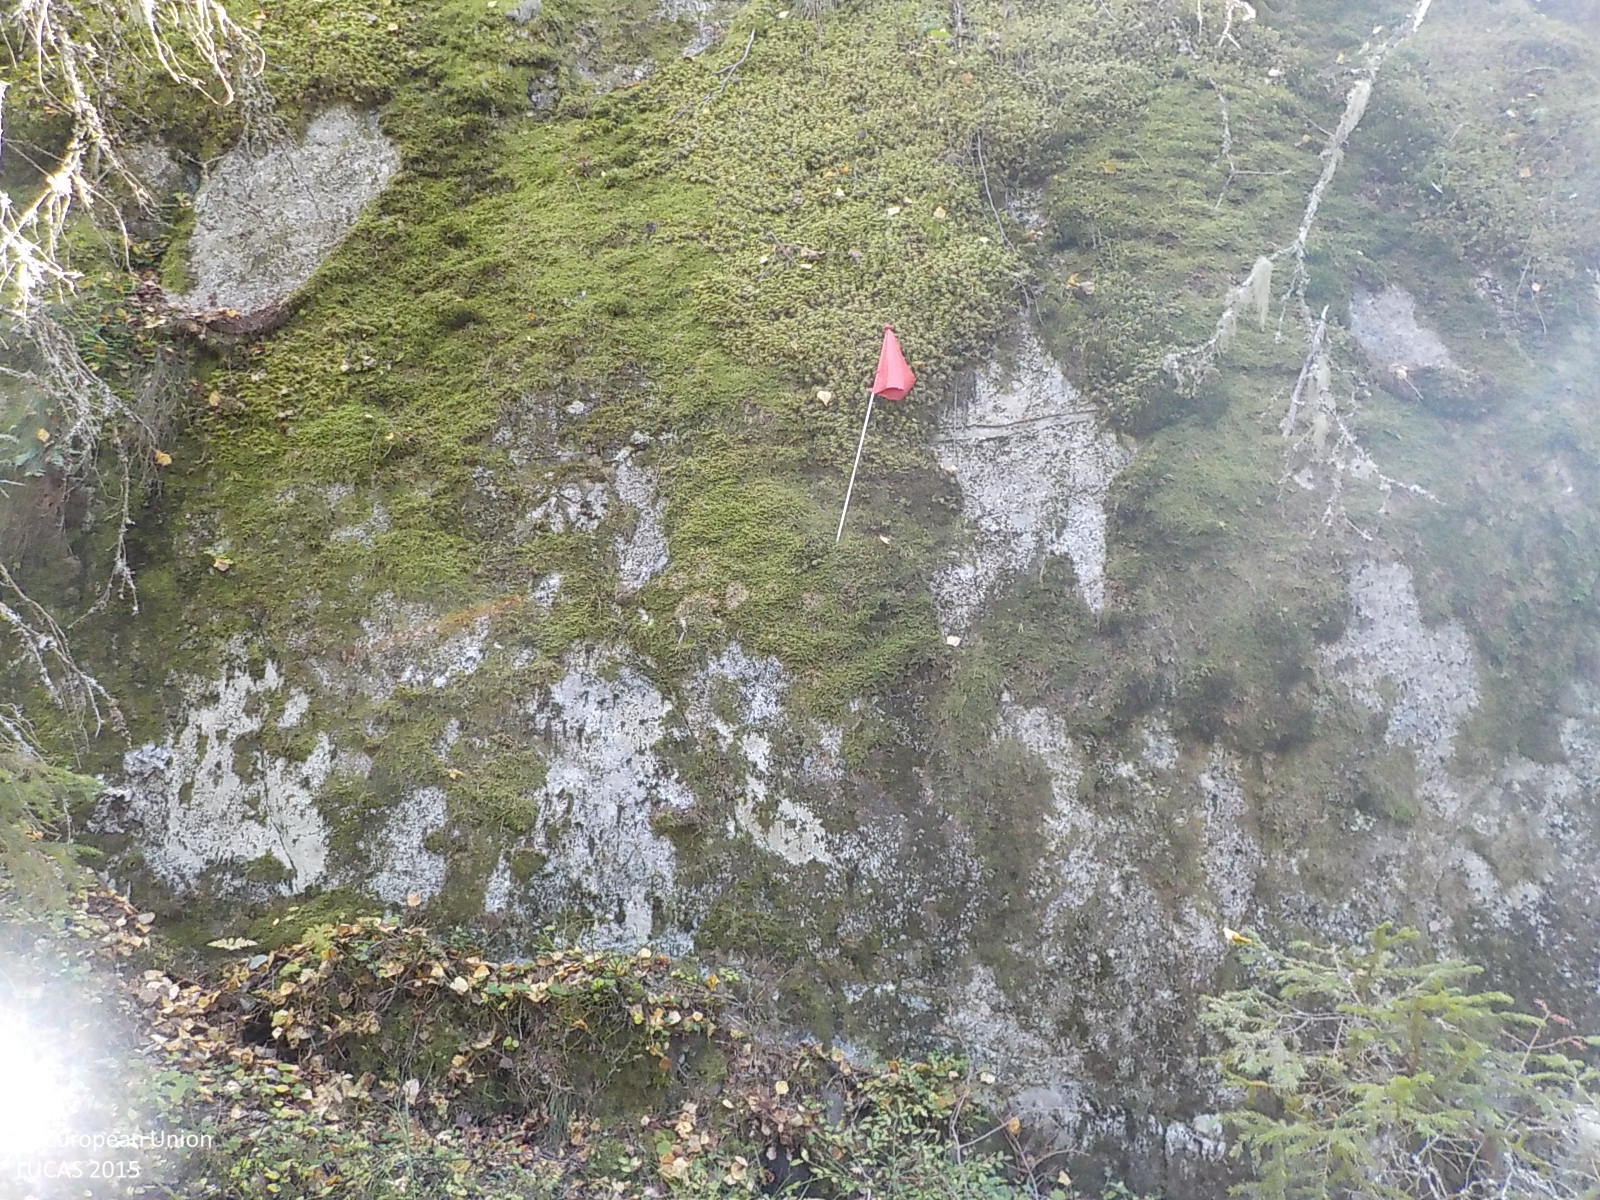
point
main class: Woodland
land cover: Spruce dominated coniferous woodland
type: boreal forest
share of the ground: > 75 %
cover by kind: coniferous forest trees 75 %, lichens and mosses 10 %, consolidated bare surface 10 %, shrubs 5 %
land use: Forestry
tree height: > 5 m
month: September
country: SE
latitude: 62.9184
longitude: 18.4659
